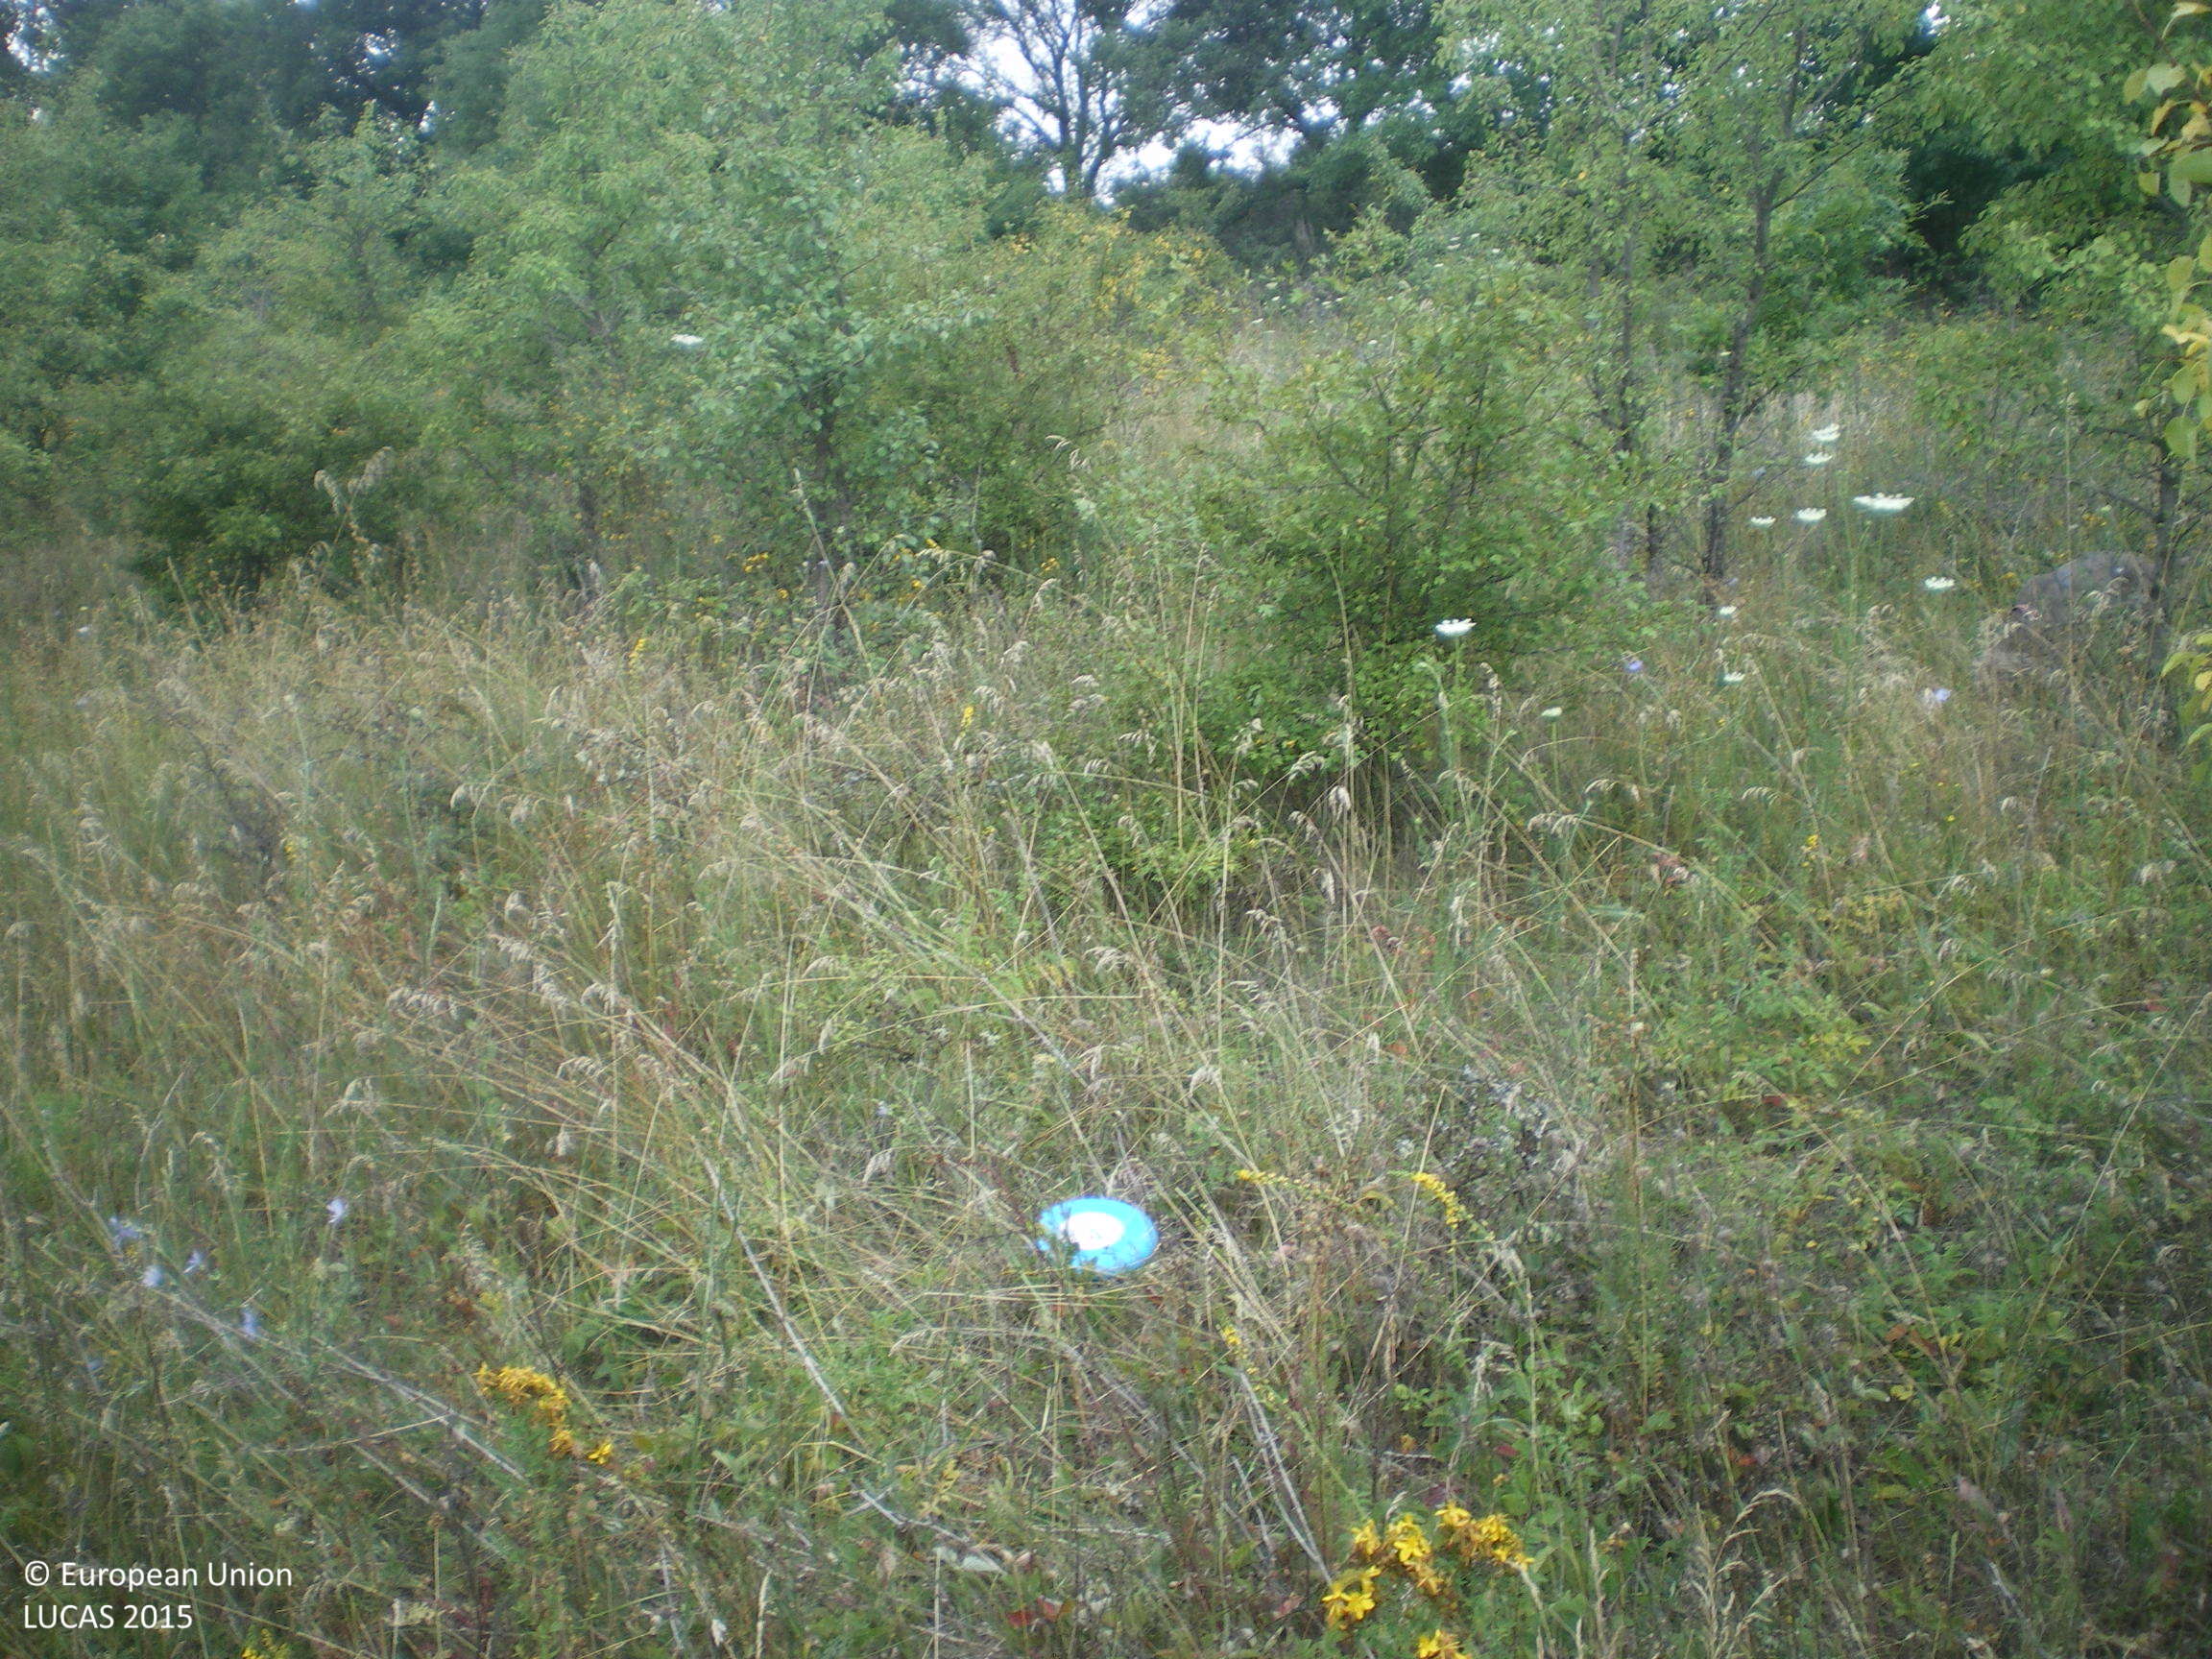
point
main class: Woodland
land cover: Broadleaved woodland
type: mesophytic deciduous forest
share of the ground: 50 - 75 %
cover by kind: broadleaved forest trees 50 %, herbaceous plants 30 %, shrubs 20 %
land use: Forestry
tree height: > 5 m
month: July
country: BG
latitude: 42.4173
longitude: 25.1929
